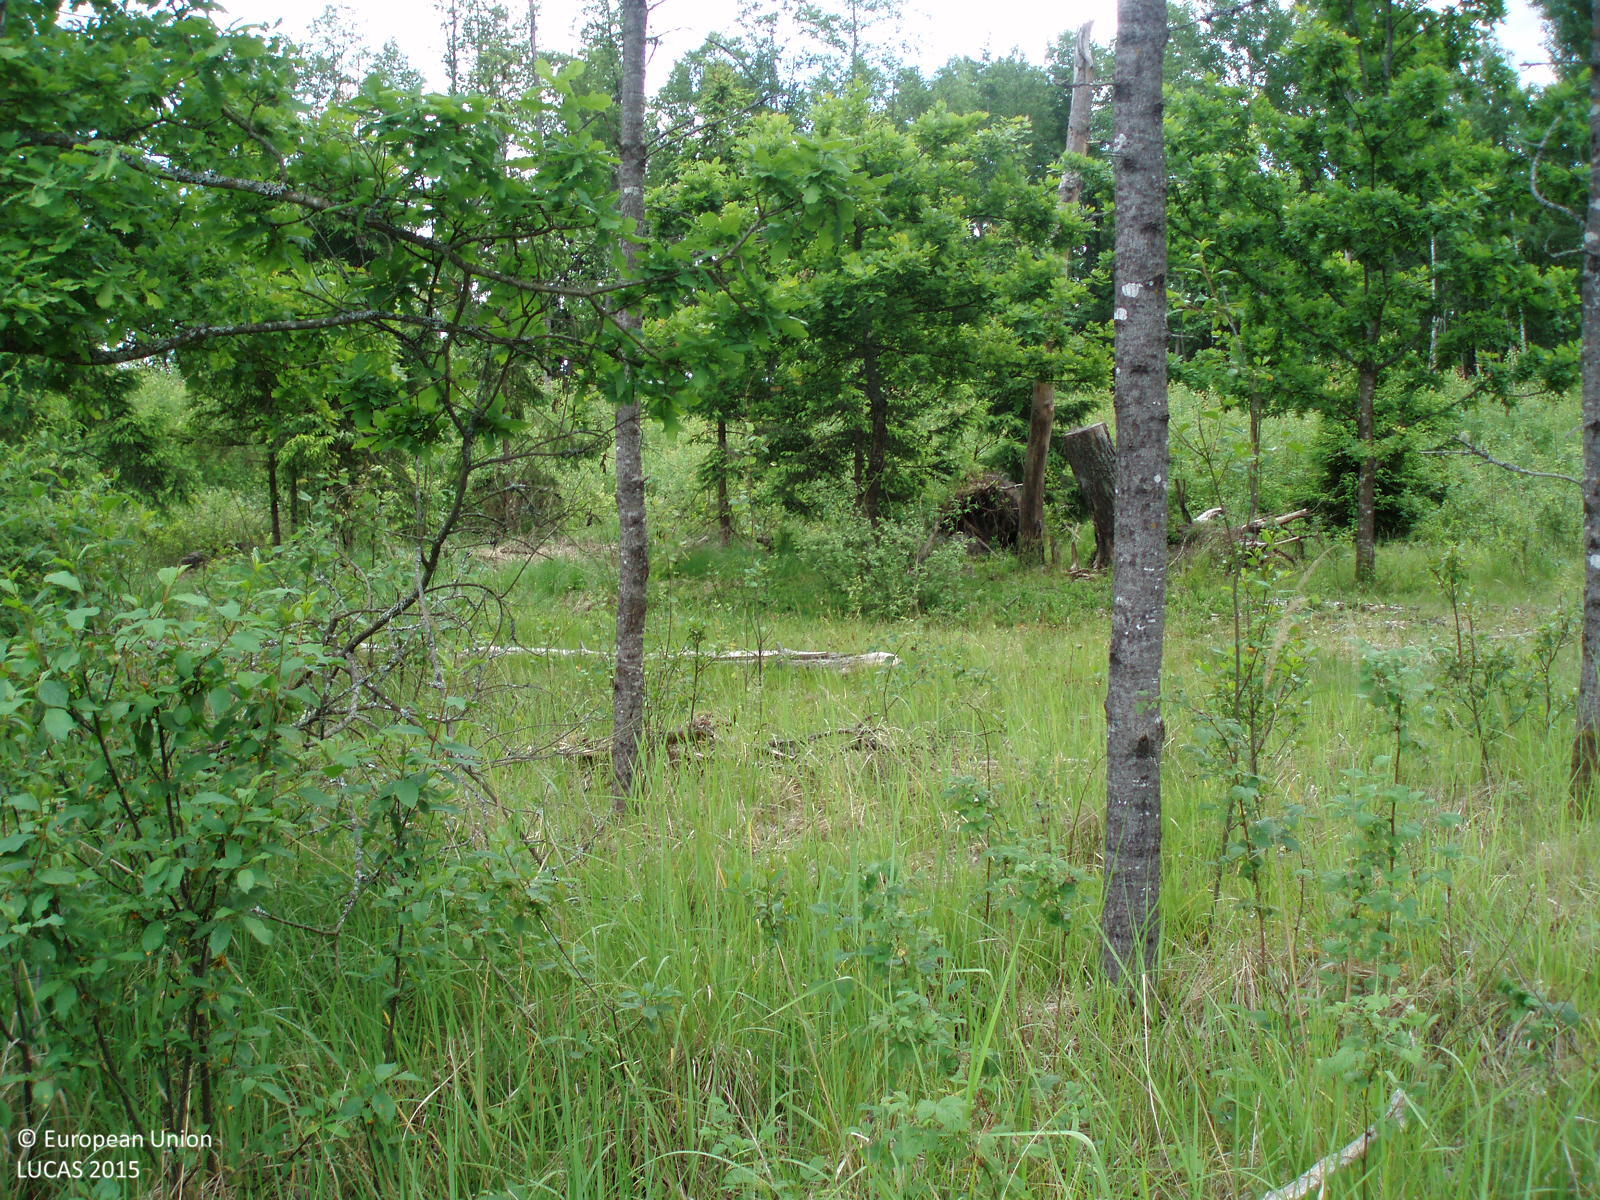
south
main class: Woodland
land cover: Broadleaved woodland
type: non-riverine alder, birch or aspen forest
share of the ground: 25 - 50 %
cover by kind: shrubs 50 %, broadleaved forest trees 30 %, herbaceous plants 20 %
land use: Forestry
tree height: < 5 m
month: June
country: LT
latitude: 55.0801
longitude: 22.5157
